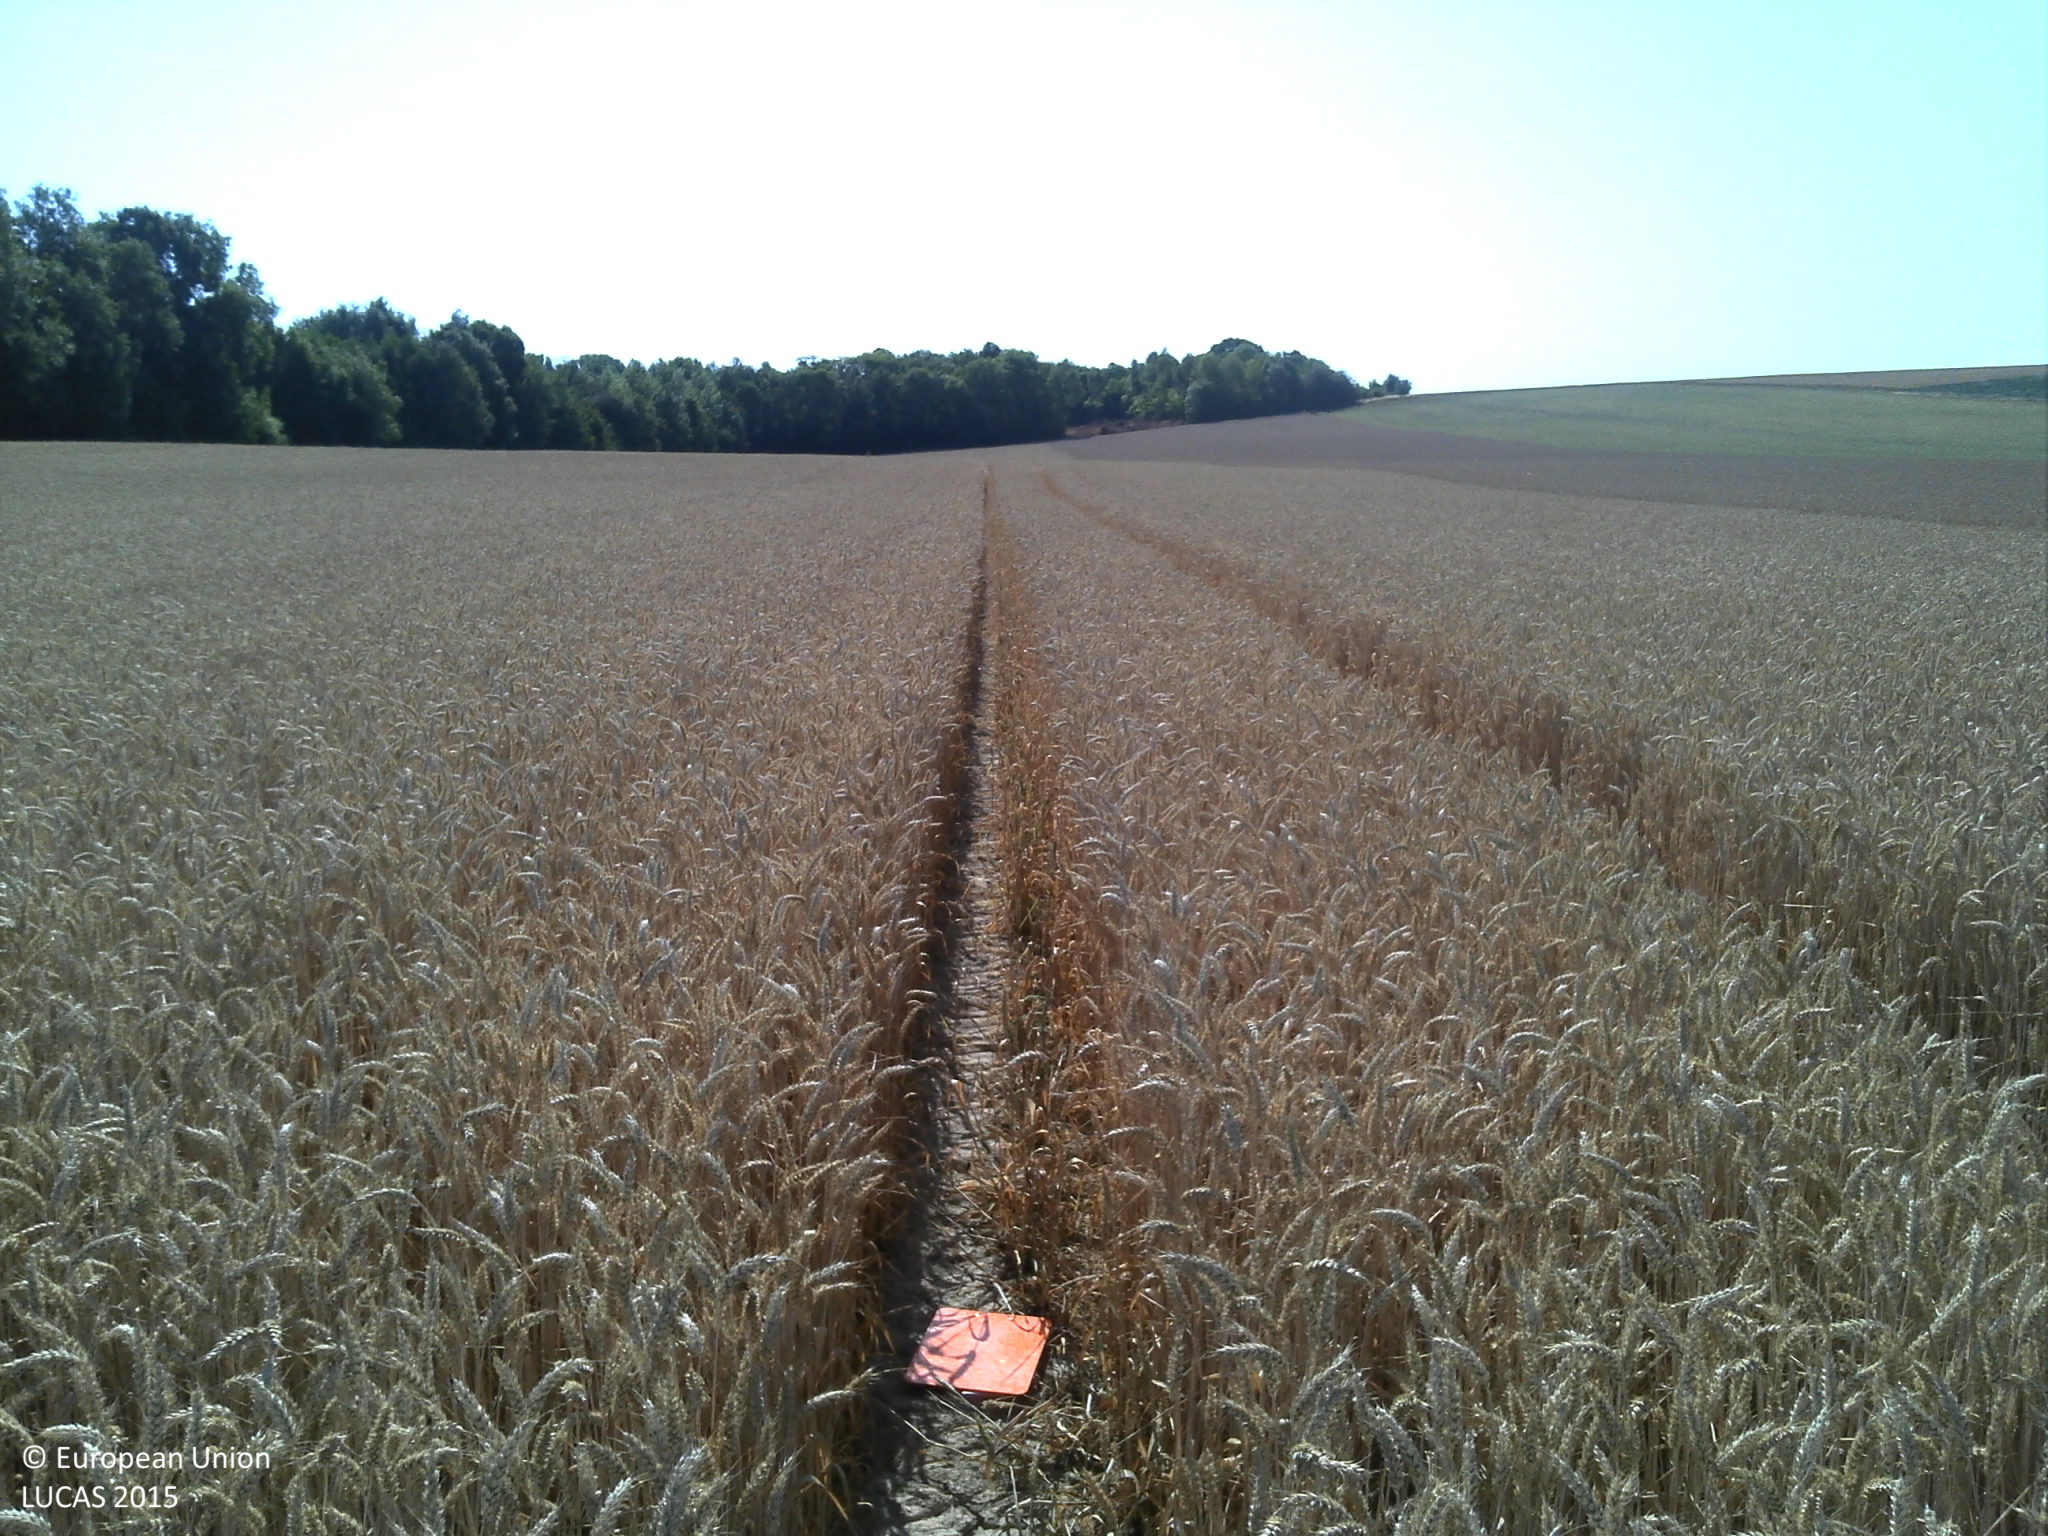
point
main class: Cropland
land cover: Common wheat
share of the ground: > 75 %
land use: Agriculture (excluding fallow land and kitchen gardens)
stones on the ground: < 10 %
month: July
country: FR
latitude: 49.4217
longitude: 4.1638
